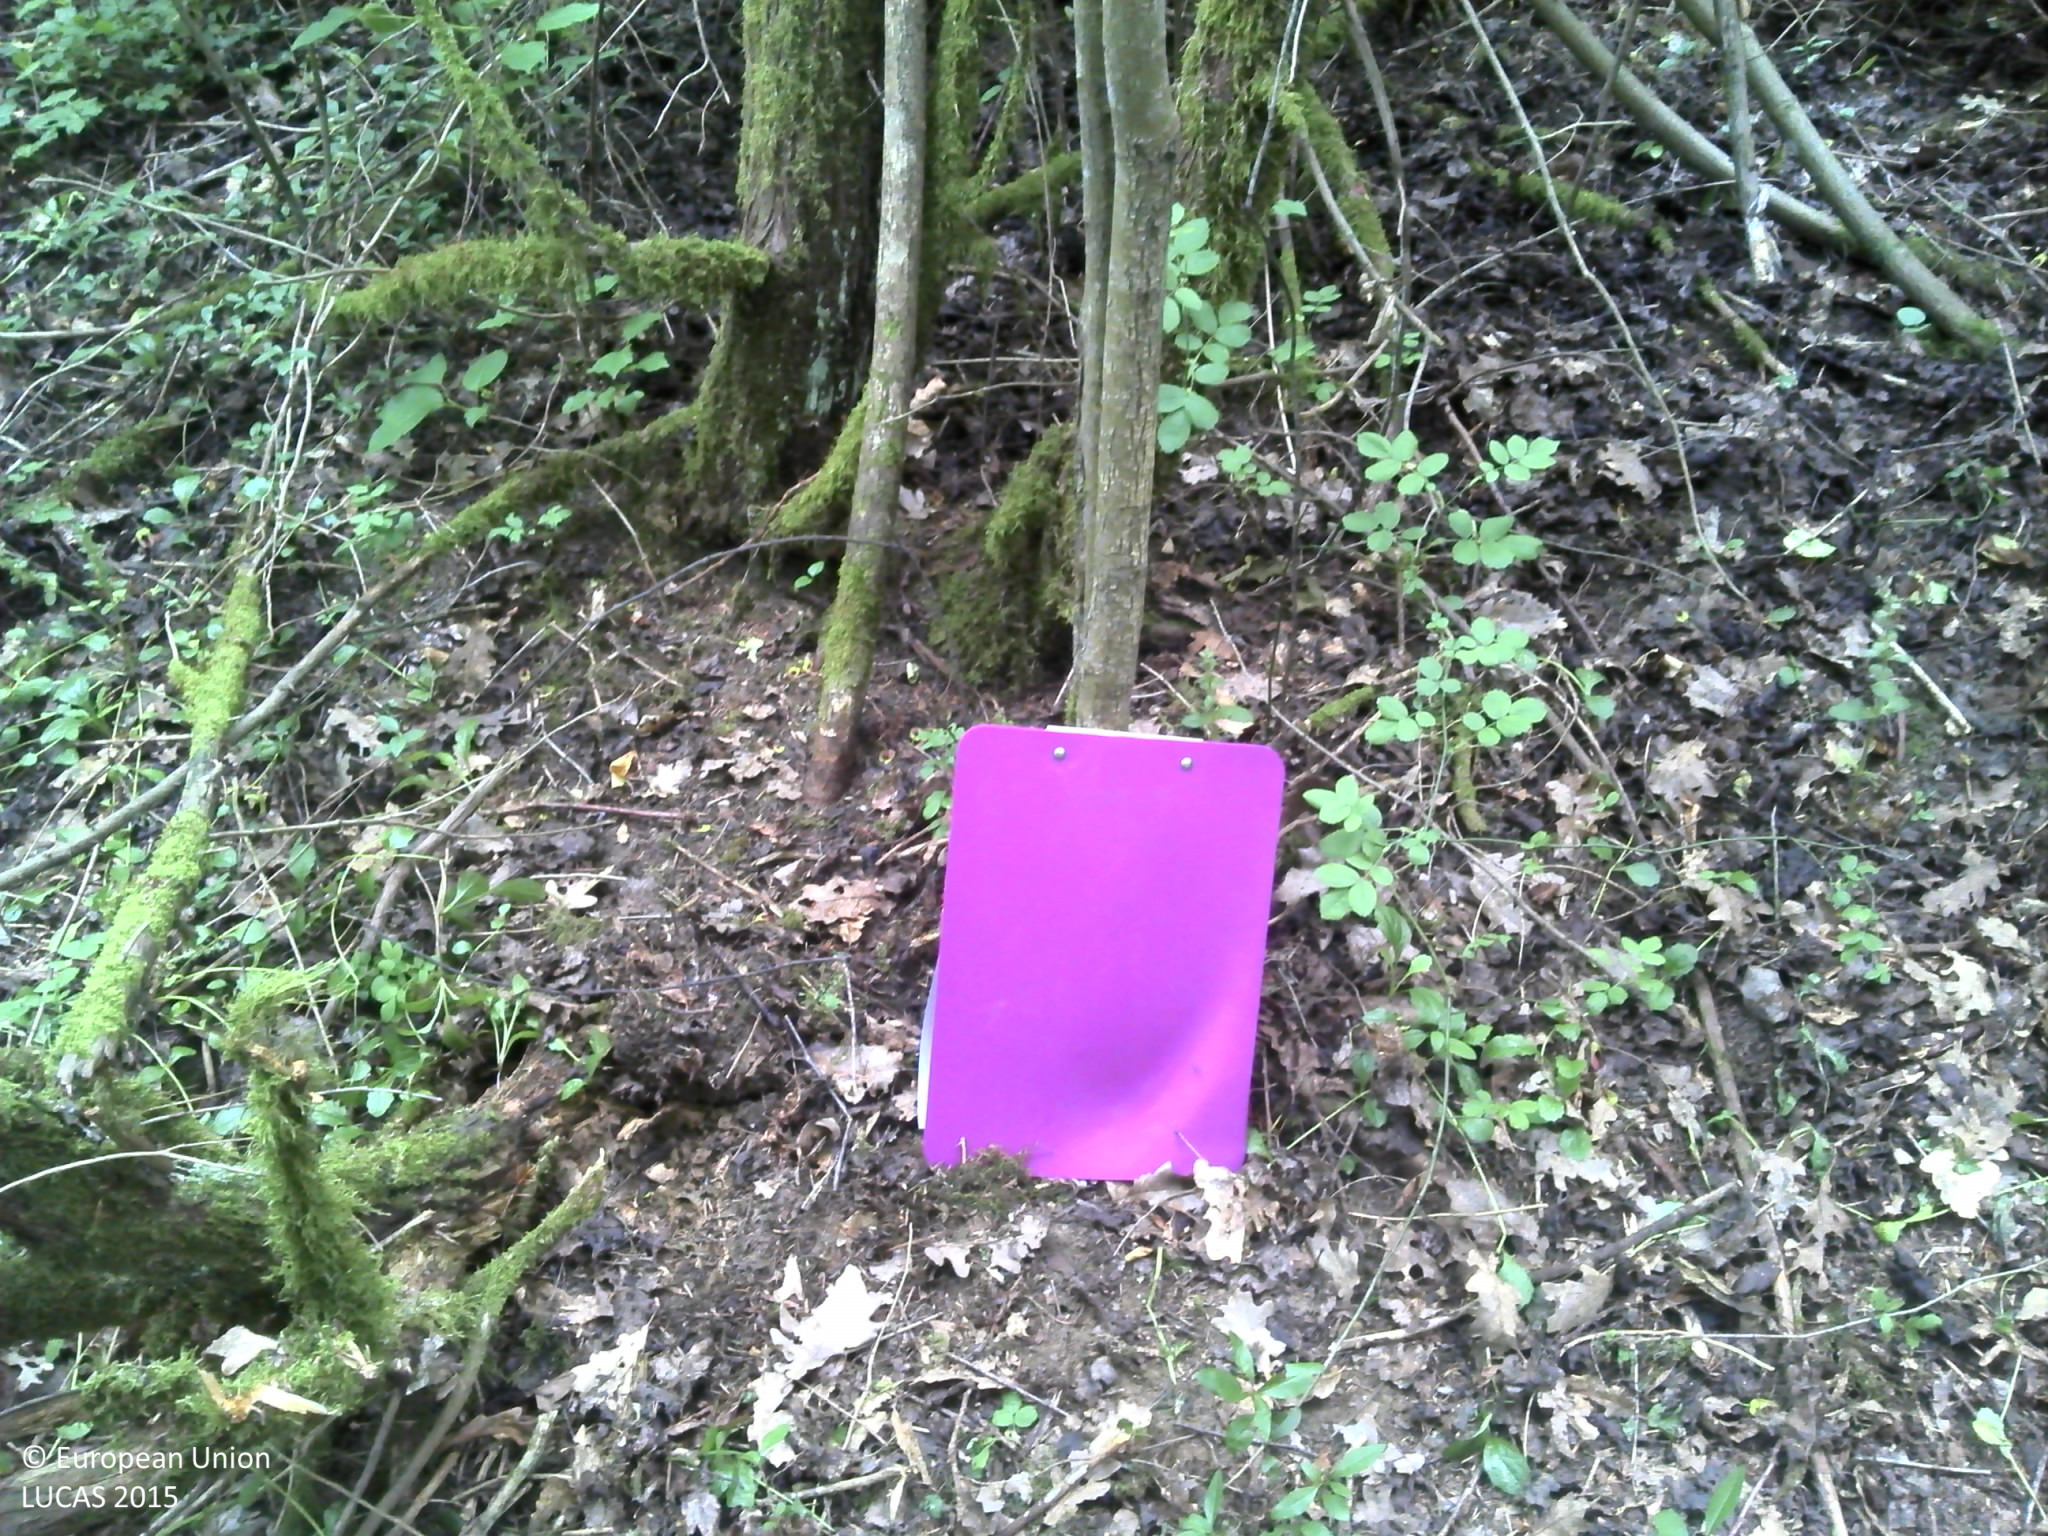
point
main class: Woodland
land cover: Broadleaved woodland
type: beech forest
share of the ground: > 75 %
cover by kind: broadleaved forest trees 100 %
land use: Forestry
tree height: > 5 m
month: June
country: HR
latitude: 45.3841
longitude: 17.4723
